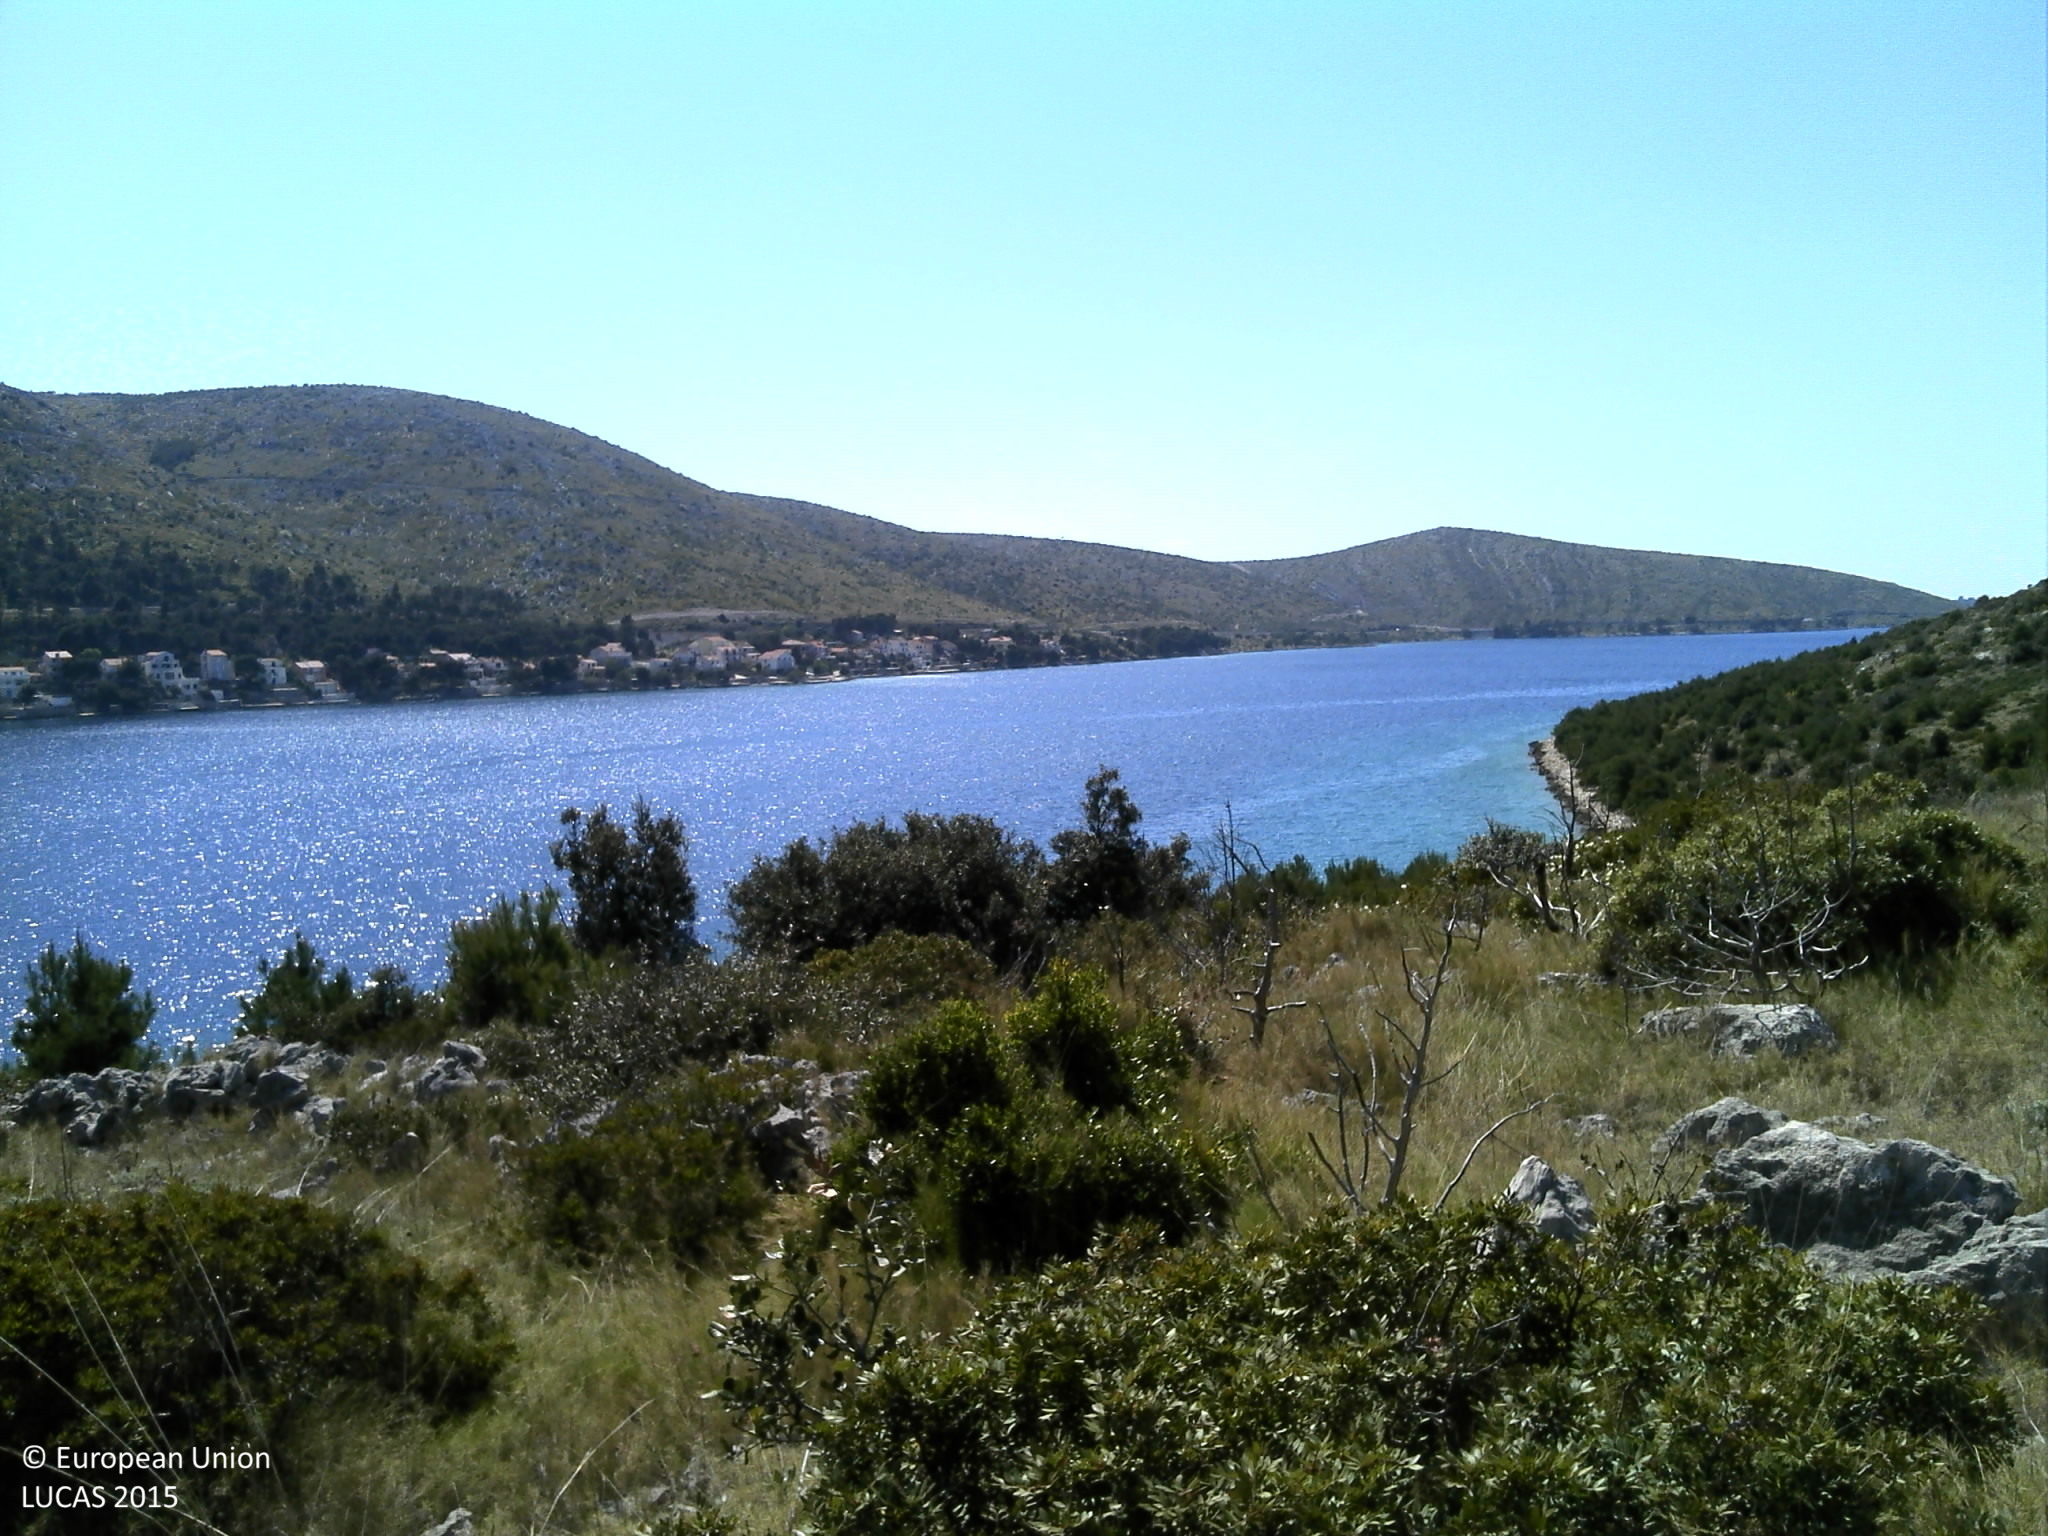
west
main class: Shrubland
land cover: Shrubland with sparse tree cover
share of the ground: 10 - 25 %
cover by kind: herbaceous plants 30 %, shrubs 25 %, consolidated bare surface 20 %, unconsolidated bare surface 20 %, coniferous forest trees 5 %
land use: Abandoned areas
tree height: < 5 m
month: April
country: HR
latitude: 43.6371
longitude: 15.9530
